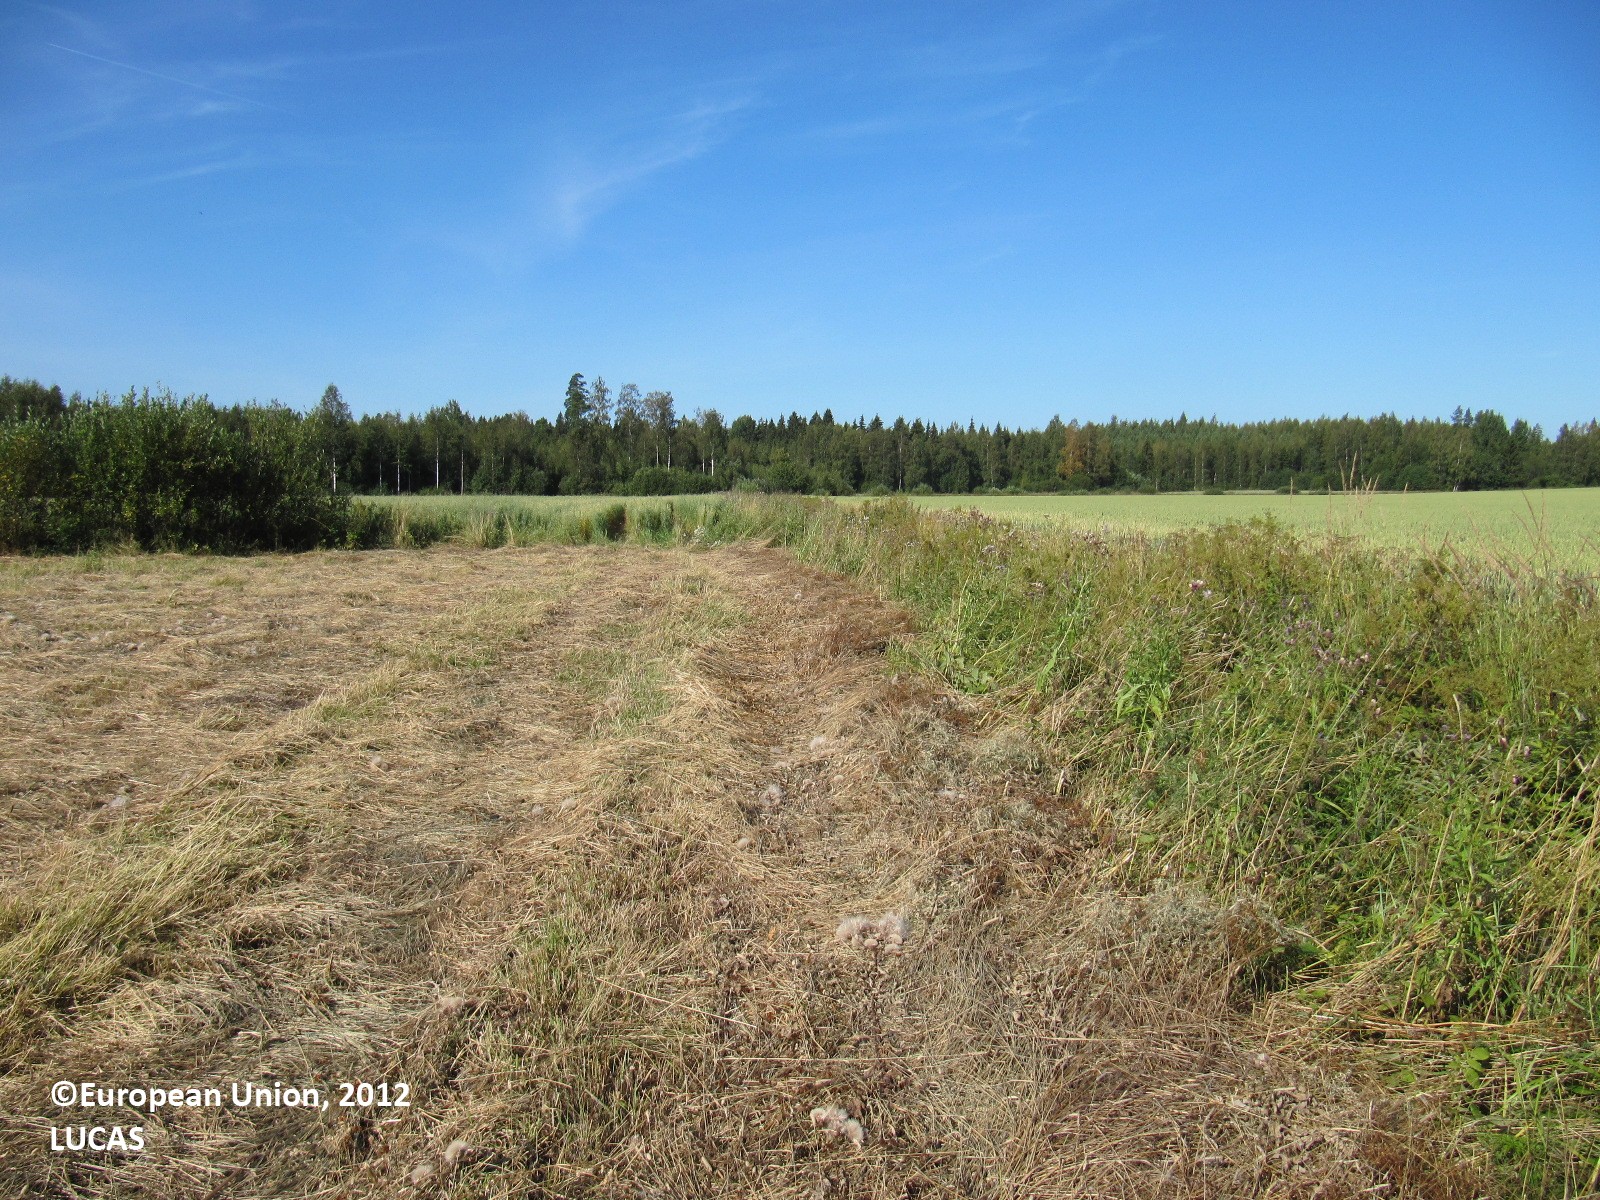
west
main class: Grassland
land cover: Grassland without tree/shrub cover
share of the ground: > 75 %
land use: Agriculture (excluding fallow land and kitchen gardens)
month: August
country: FI
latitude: 60.7080
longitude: 24.5255
